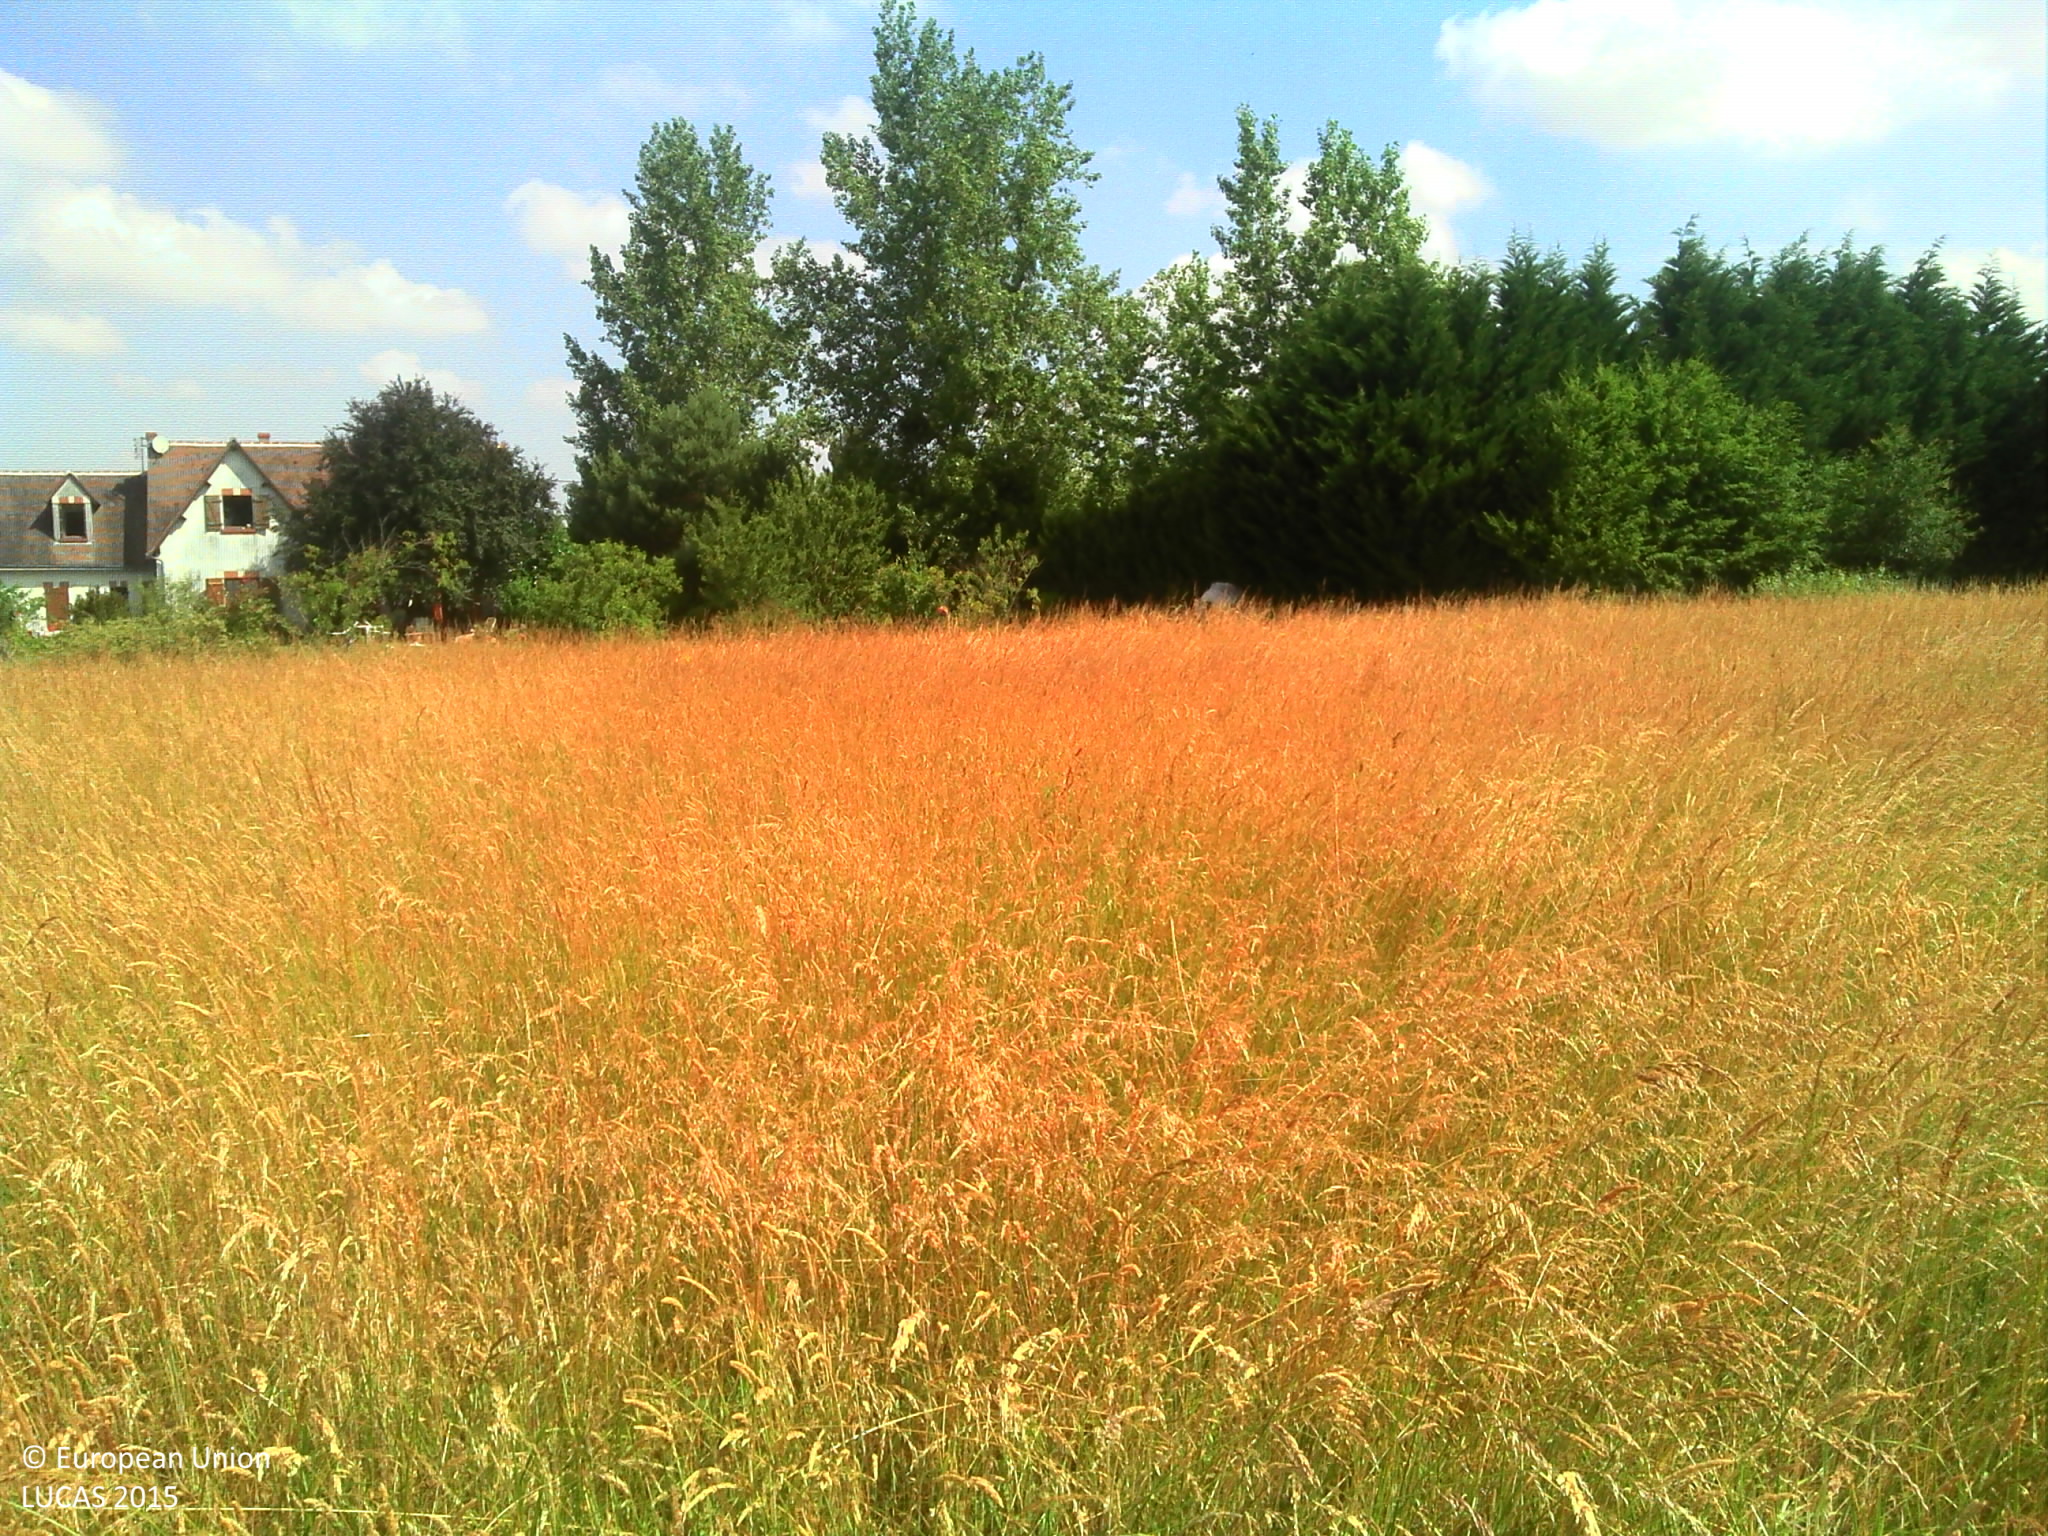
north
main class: Grassland
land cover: Grassland without tree/shrub cover
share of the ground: > 75 %
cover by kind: herbaceous plants 100 %
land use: Agriculture (excluding fallow land and kitchen gardens)
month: June
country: FR
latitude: 47.6022
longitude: 1.4596
